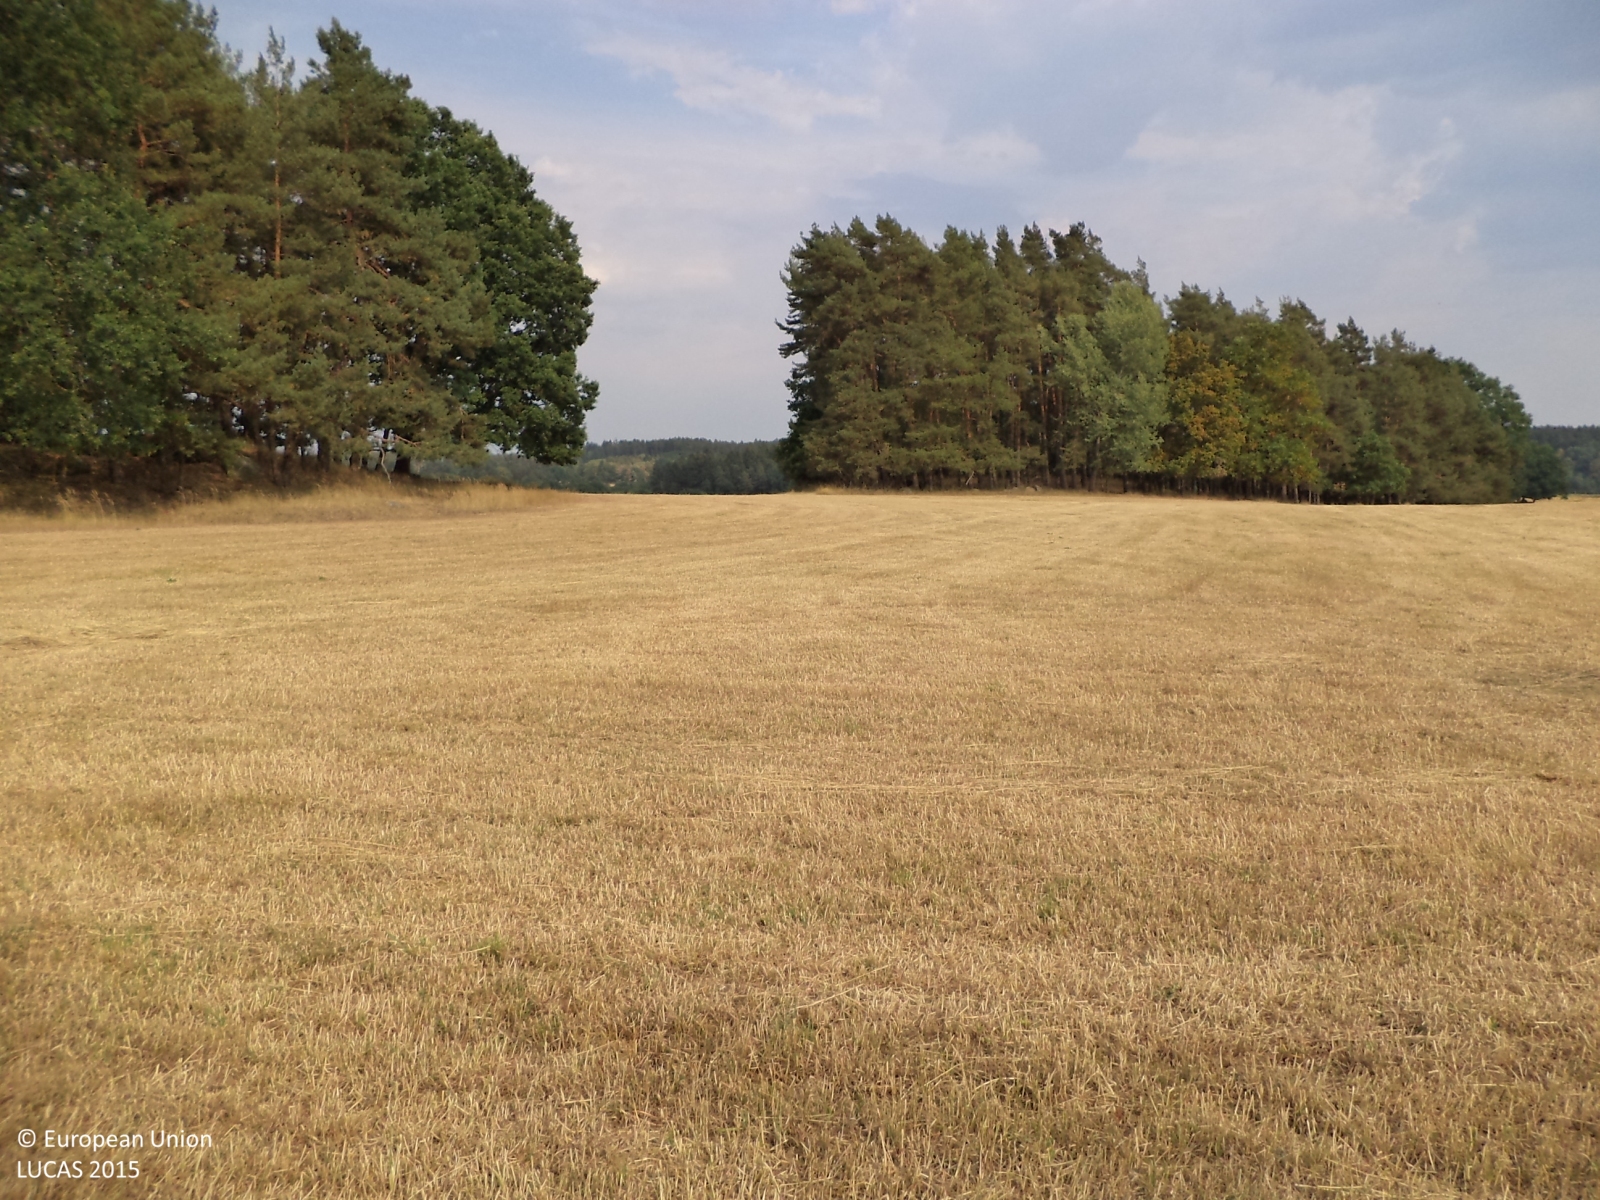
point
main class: Grassland
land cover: Grassland without tree/shrub cover
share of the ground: > 75 %
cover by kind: herbaceous plants 100 %
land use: Agriculture (excluding fallow land and kitchen gardens)
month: August
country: CZ
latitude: 49.5090
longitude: 14.2962
